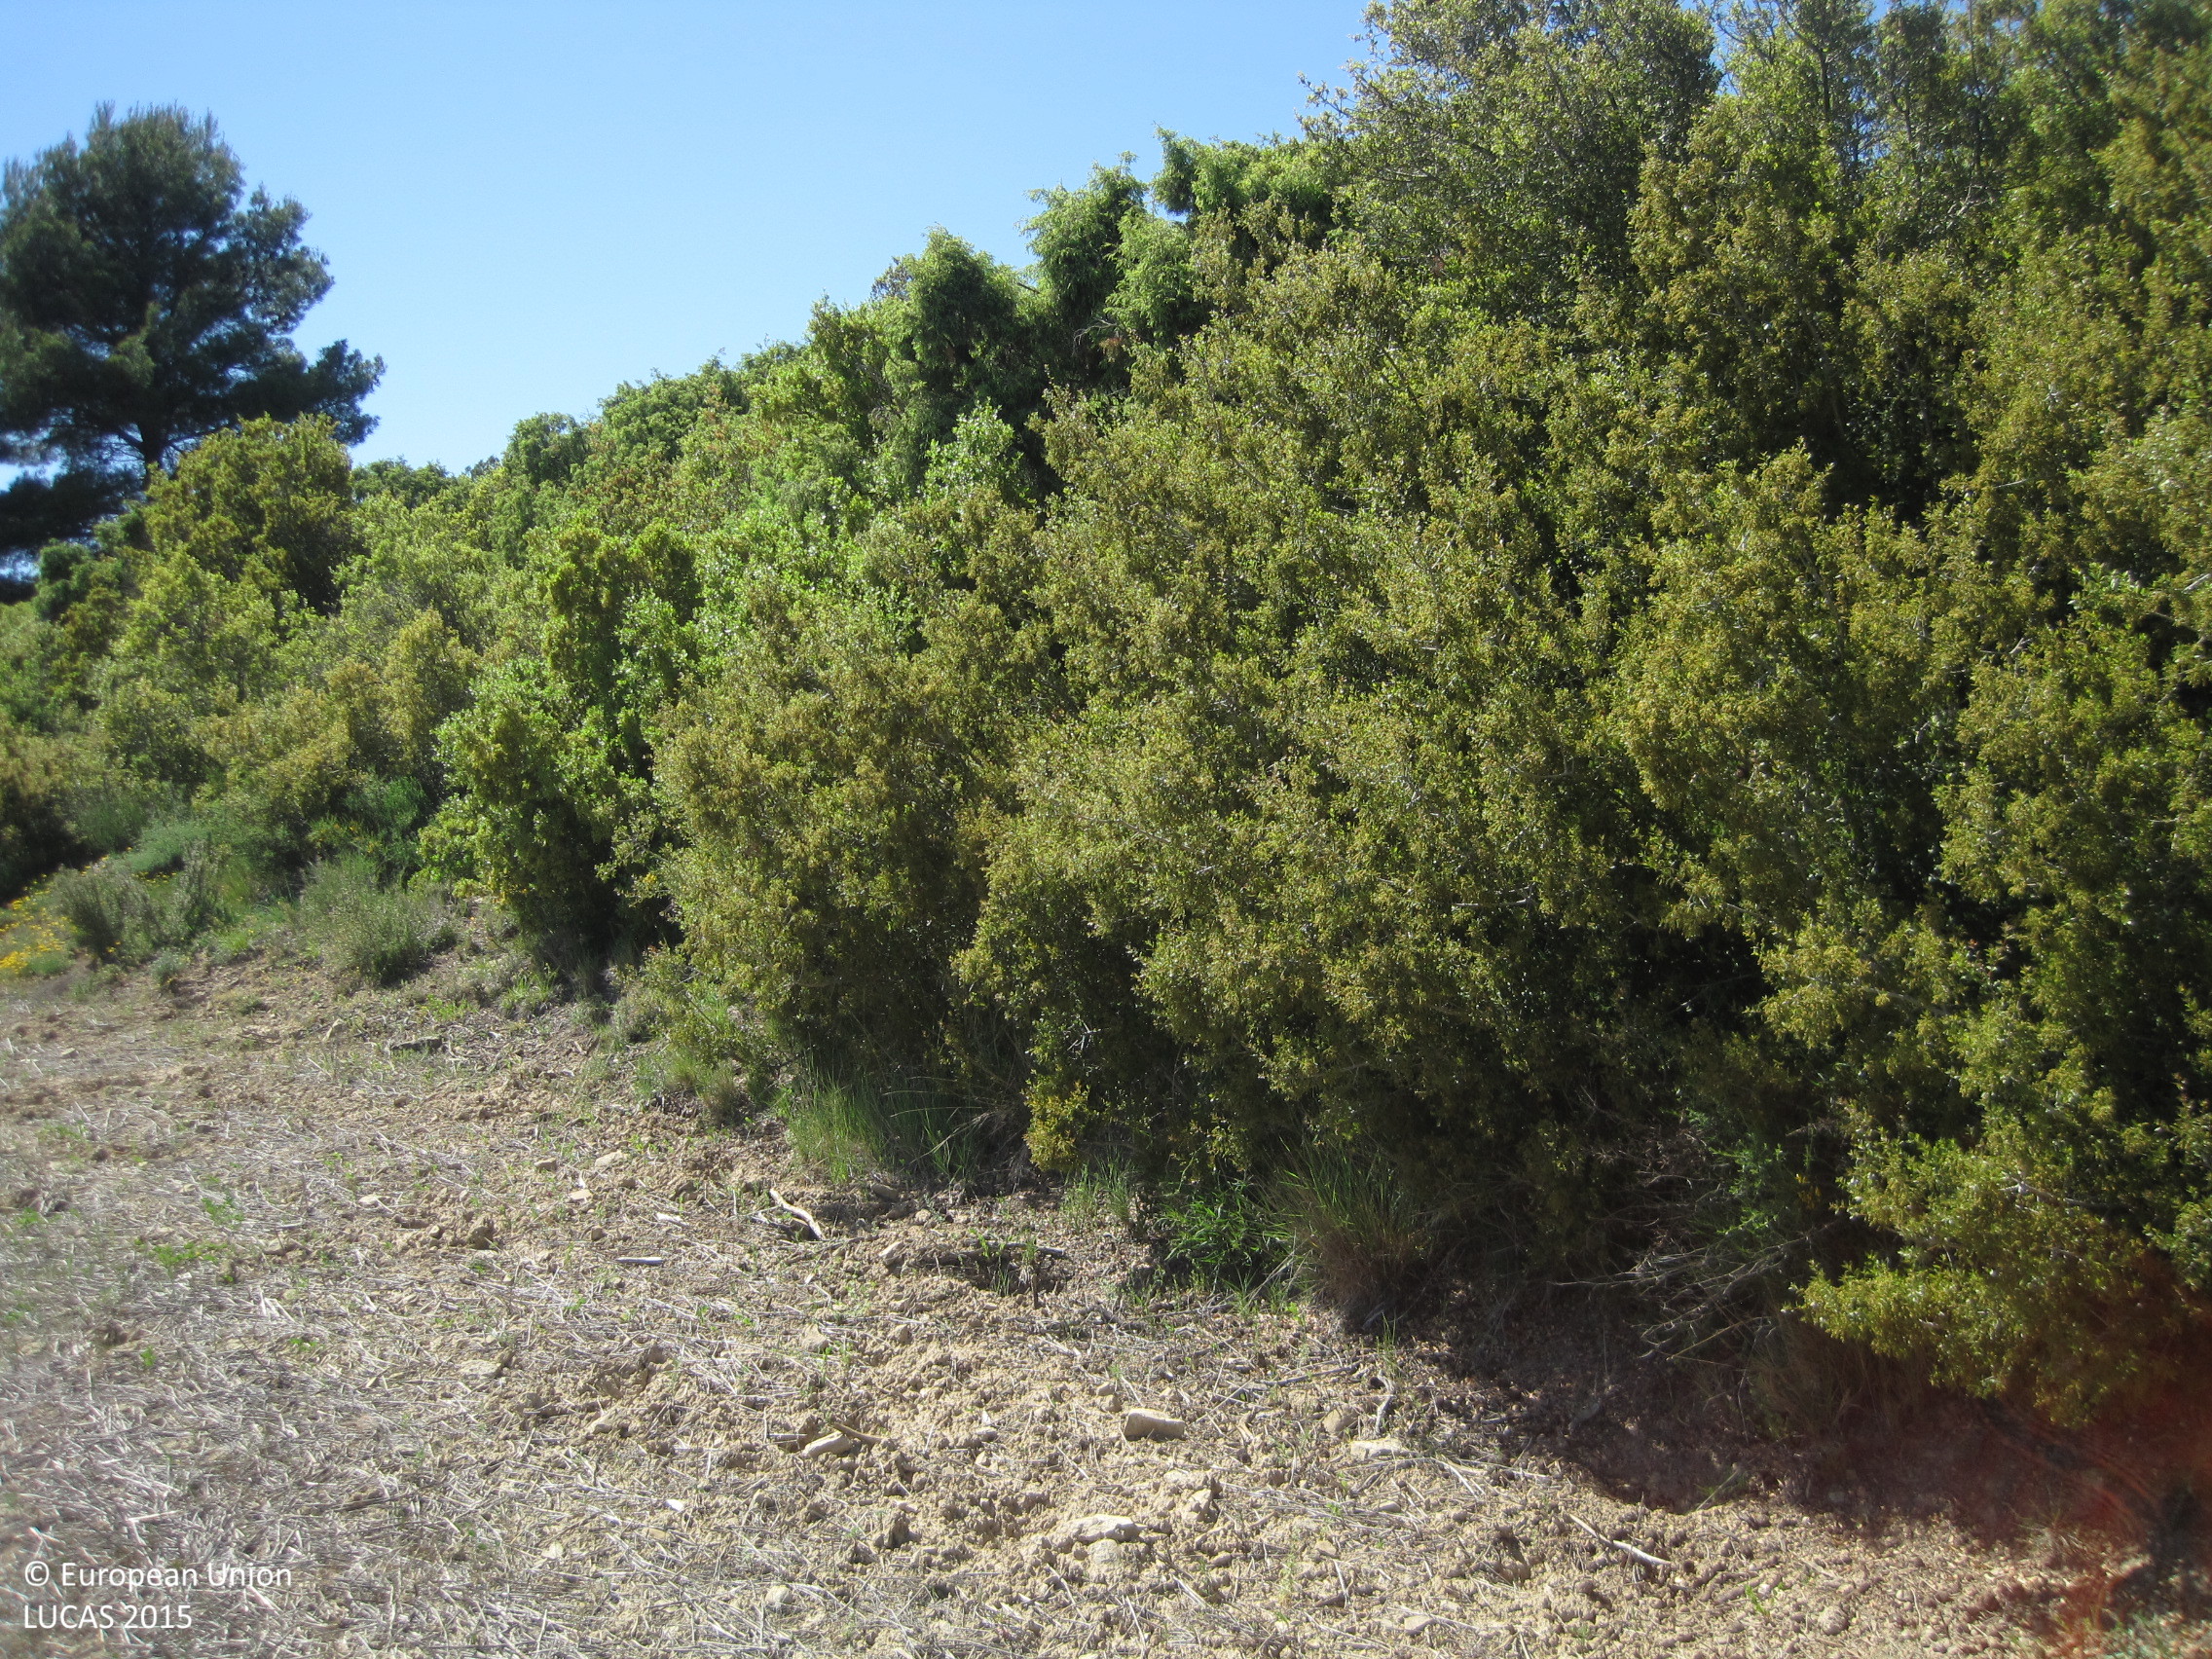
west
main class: Grassland
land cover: Spontaneously vegetated surfaces
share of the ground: > 75 %
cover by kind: herbaceous plants 60 %, unconsolidated bare surface 40 %
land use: Fallow land
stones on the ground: < 10 %
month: May
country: ES
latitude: 42.5303
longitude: -1.6141
